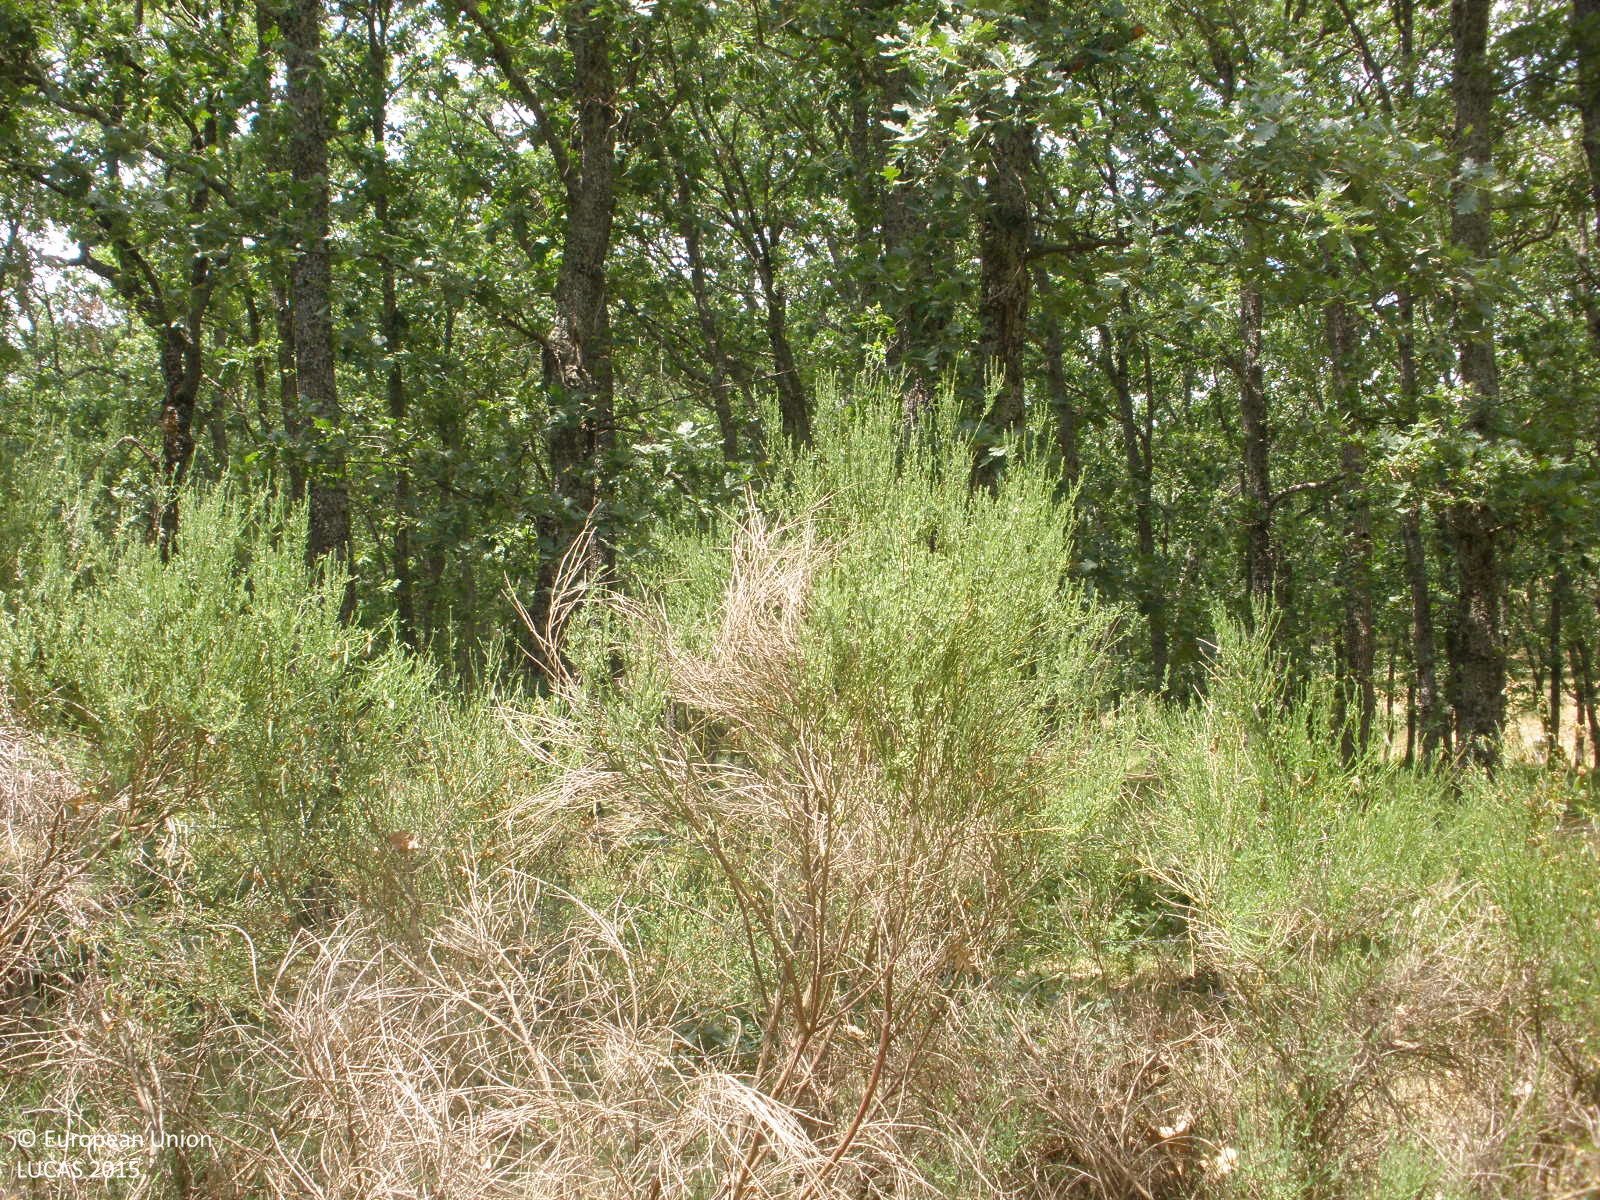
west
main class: Woodland
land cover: Broadleaved woodland
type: thermophilous deciduous forest
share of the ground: > 75 %
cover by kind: broadleaved forest trees 70 %, herbaceous plants 30 %
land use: Agriculture (excluding fallow land and kitchen gardens)
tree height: > 5 m
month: June
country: ES
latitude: 40.5566
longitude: -6.1540
